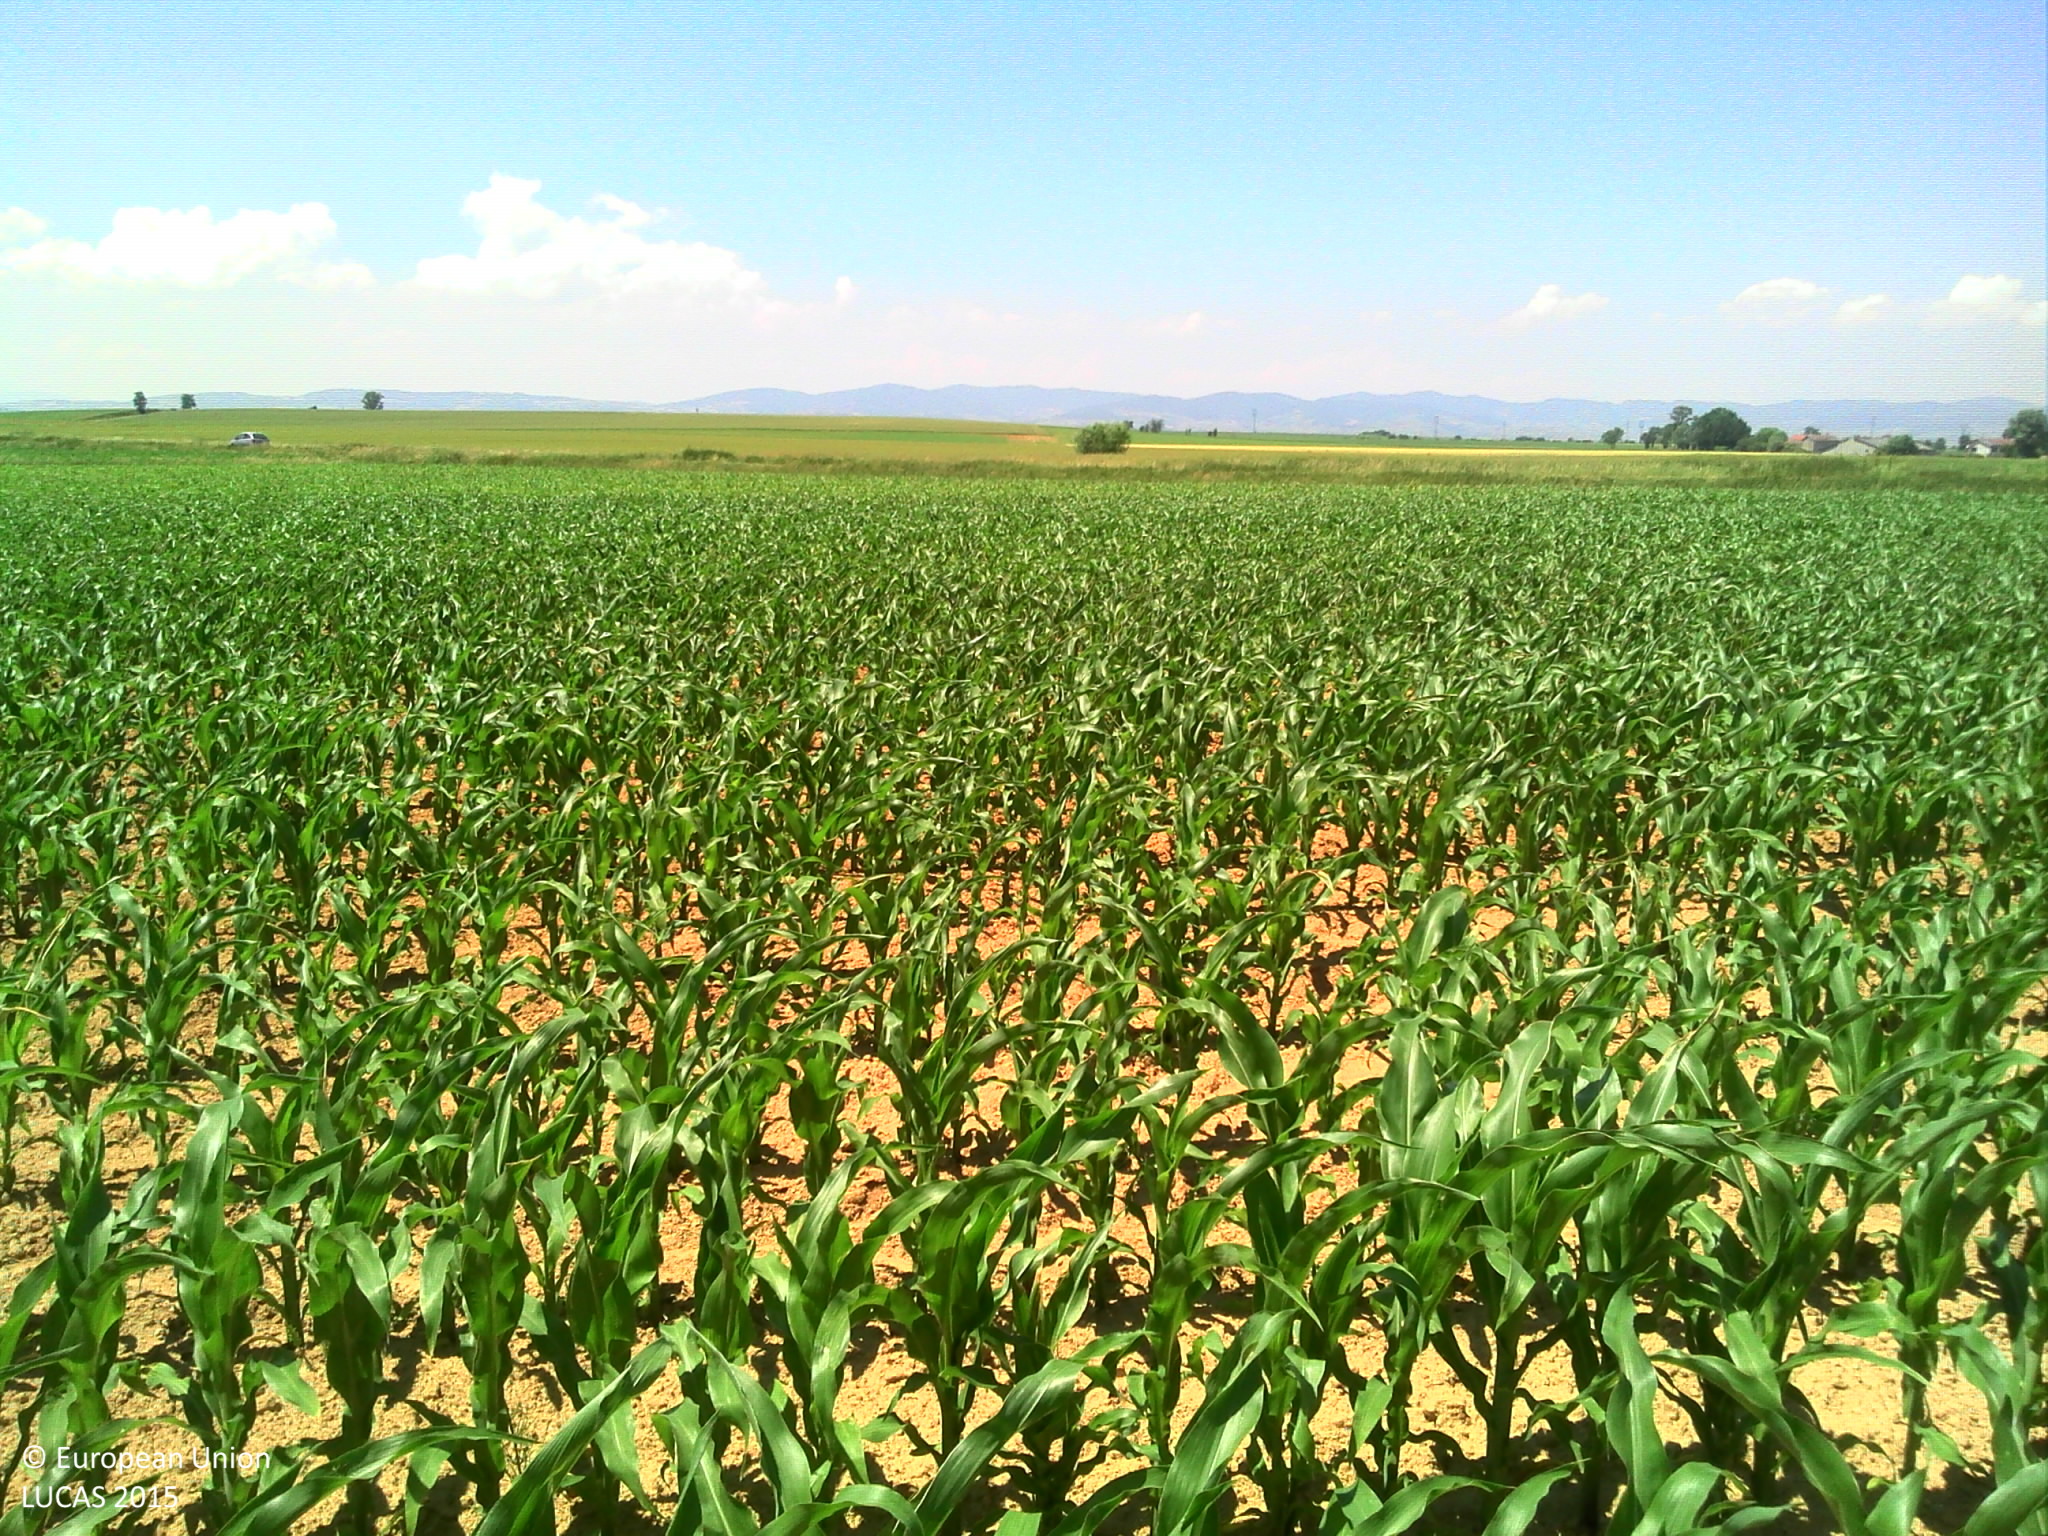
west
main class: Cropland
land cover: Maize
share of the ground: 10 - 25 %
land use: Agriculture (excluding fallow land and kitchen gardens)
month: June
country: FR
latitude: 46.0093
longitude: 4.8242
